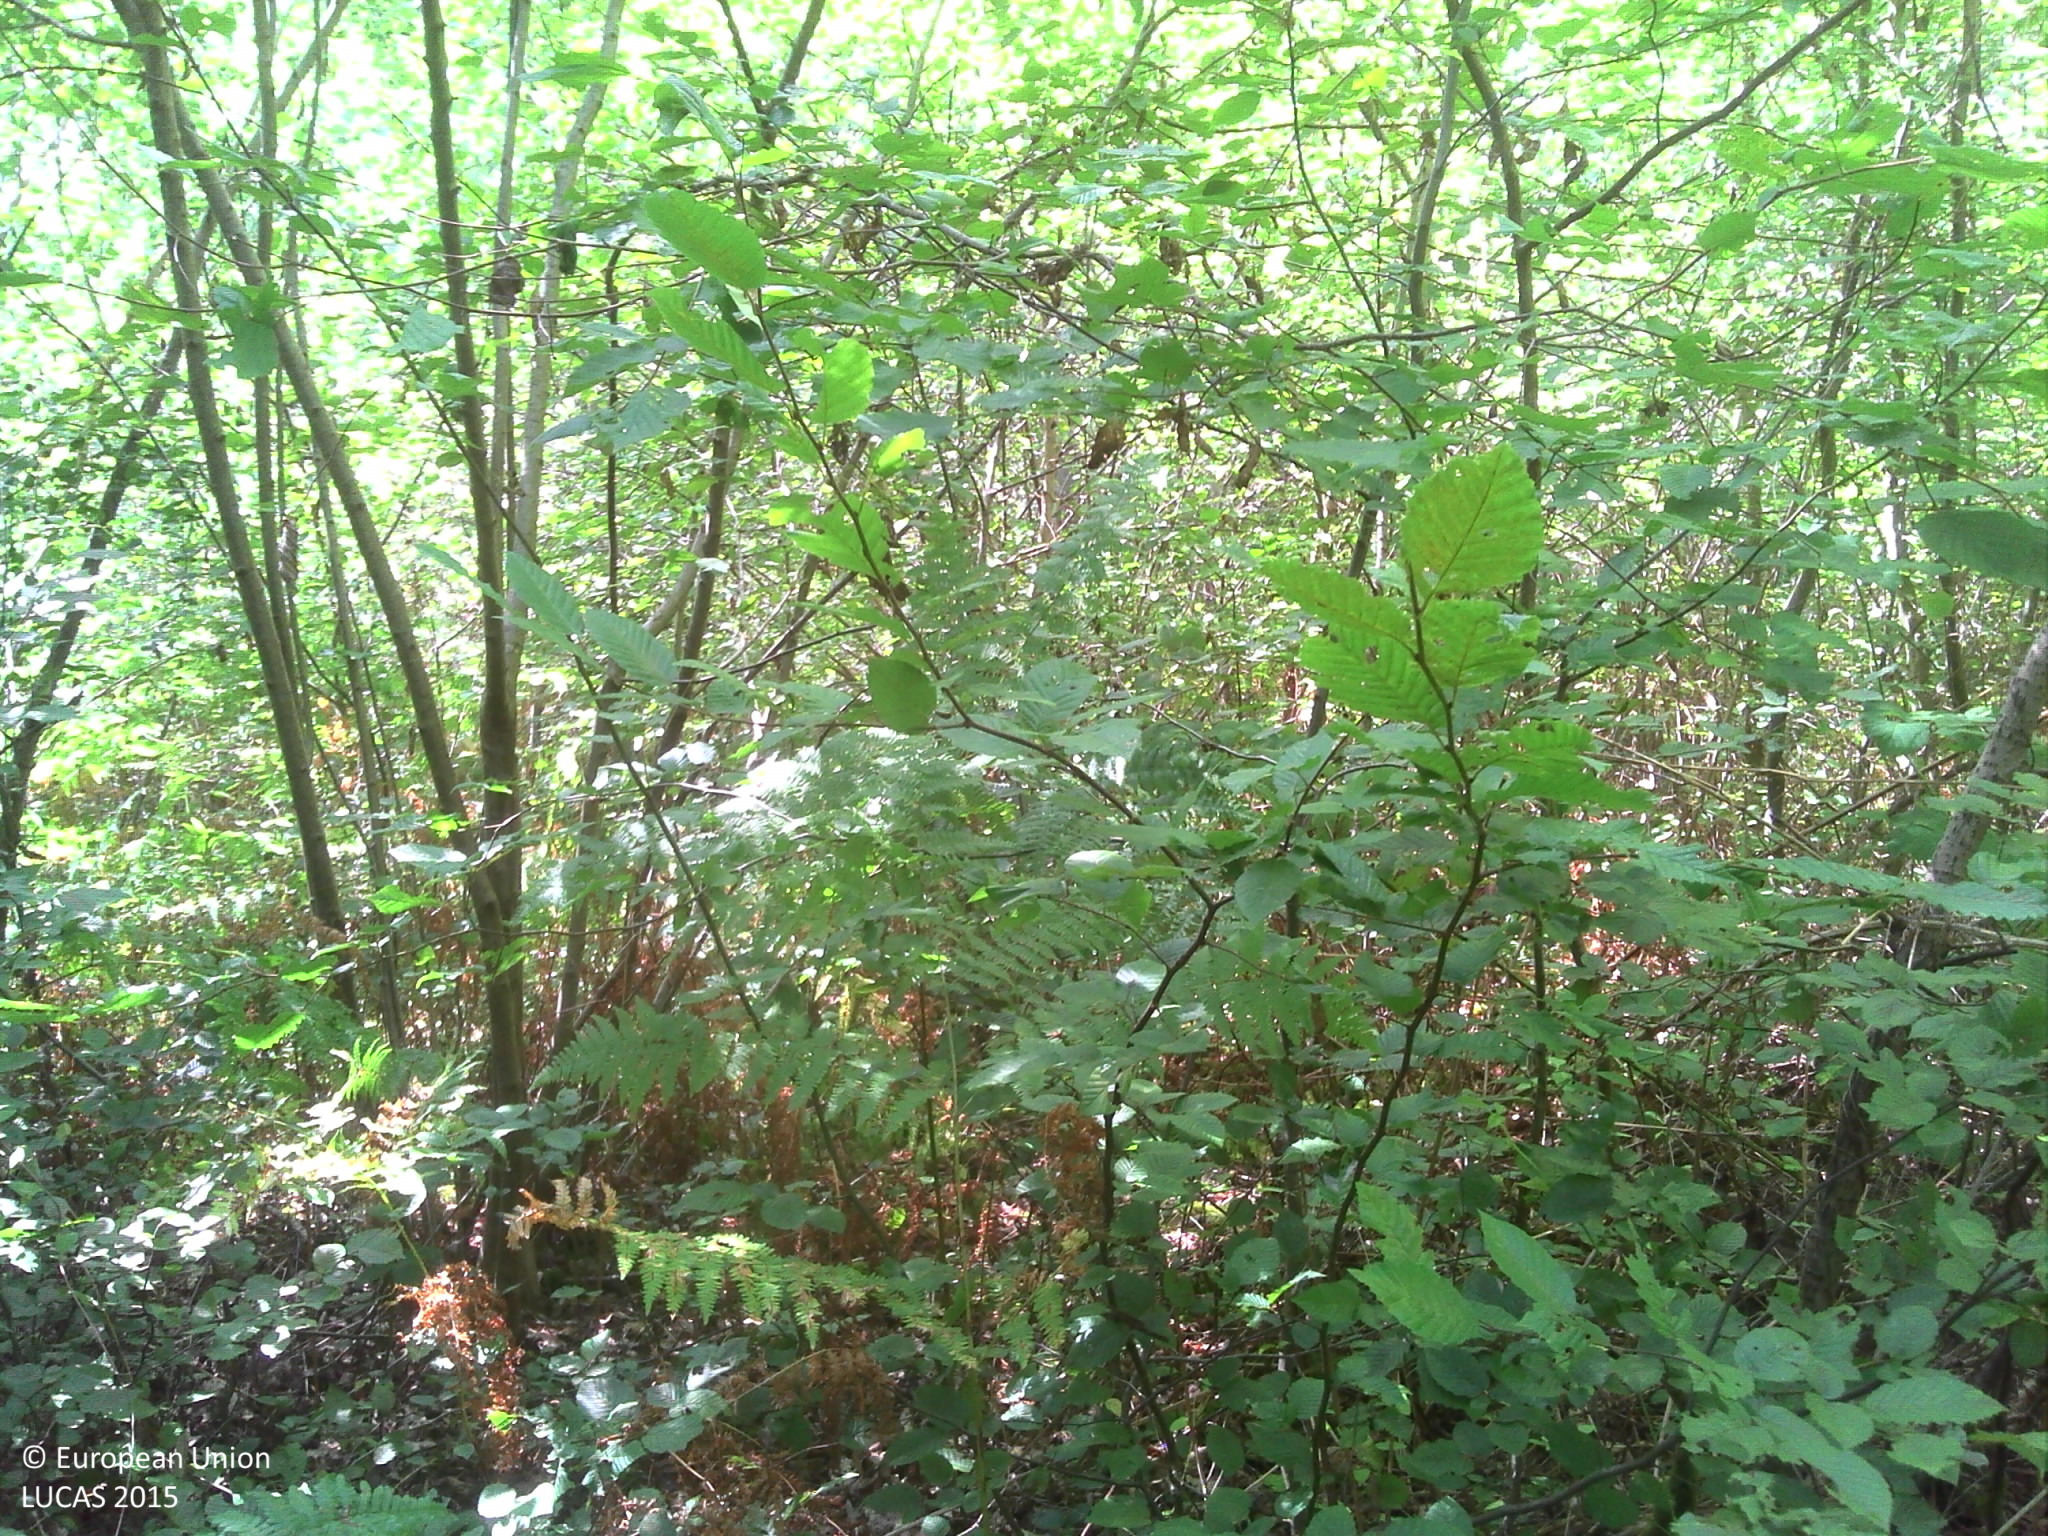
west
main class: Woodland
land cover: Broadleaved woodland
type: mesophytic deciduous forest
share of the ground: > 75 %
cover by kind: broadleaved forest trees 60 %, herbaceous plants 35 %, shrubs 5 %
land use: Forestry
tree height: > 5 m
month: July
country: FR
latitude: 46.6623
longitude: 4.8916
